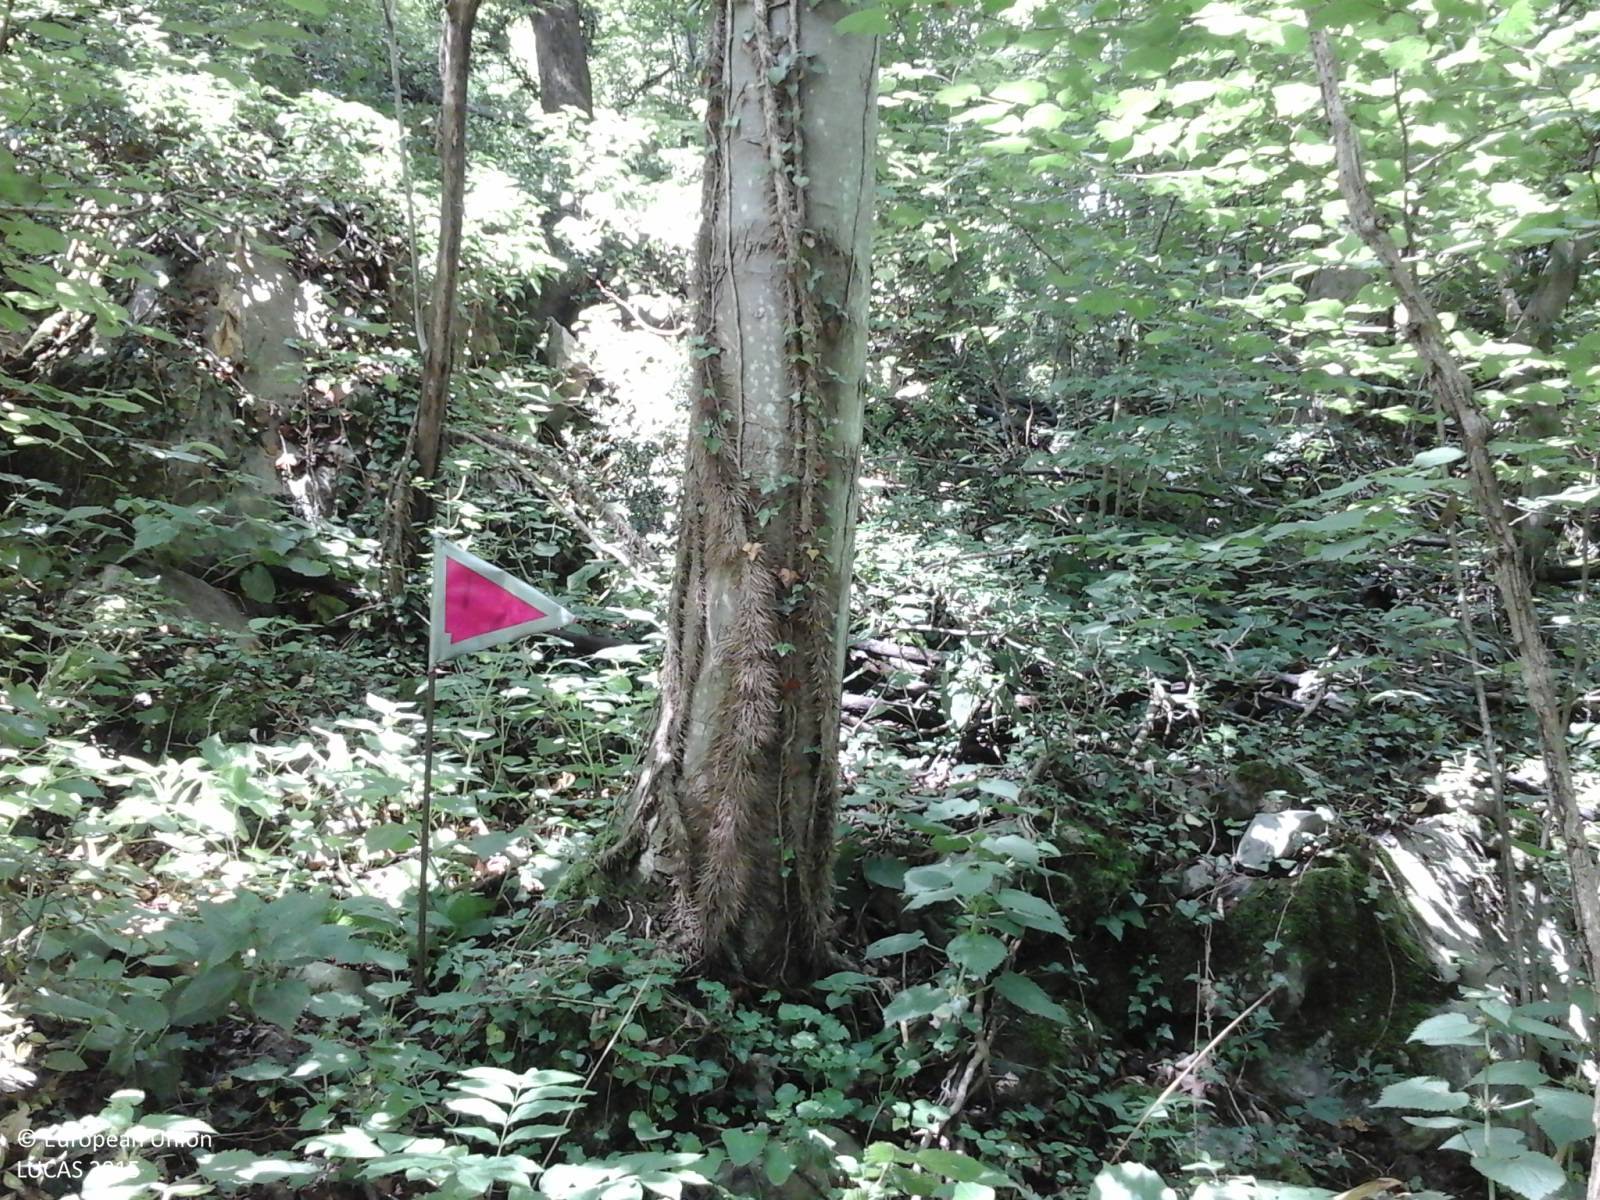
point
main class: Woodland
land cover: Broadleaved woodland
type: mesophytic deciduous forest
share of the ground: > 75 %
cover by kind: broadleaved forest trees 80 %, coniferous forest trees 10 %, shrubs 10 %
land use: Forestry
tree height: > 5 m
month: June
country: IT
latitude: 46.1299
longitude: 13.5557
